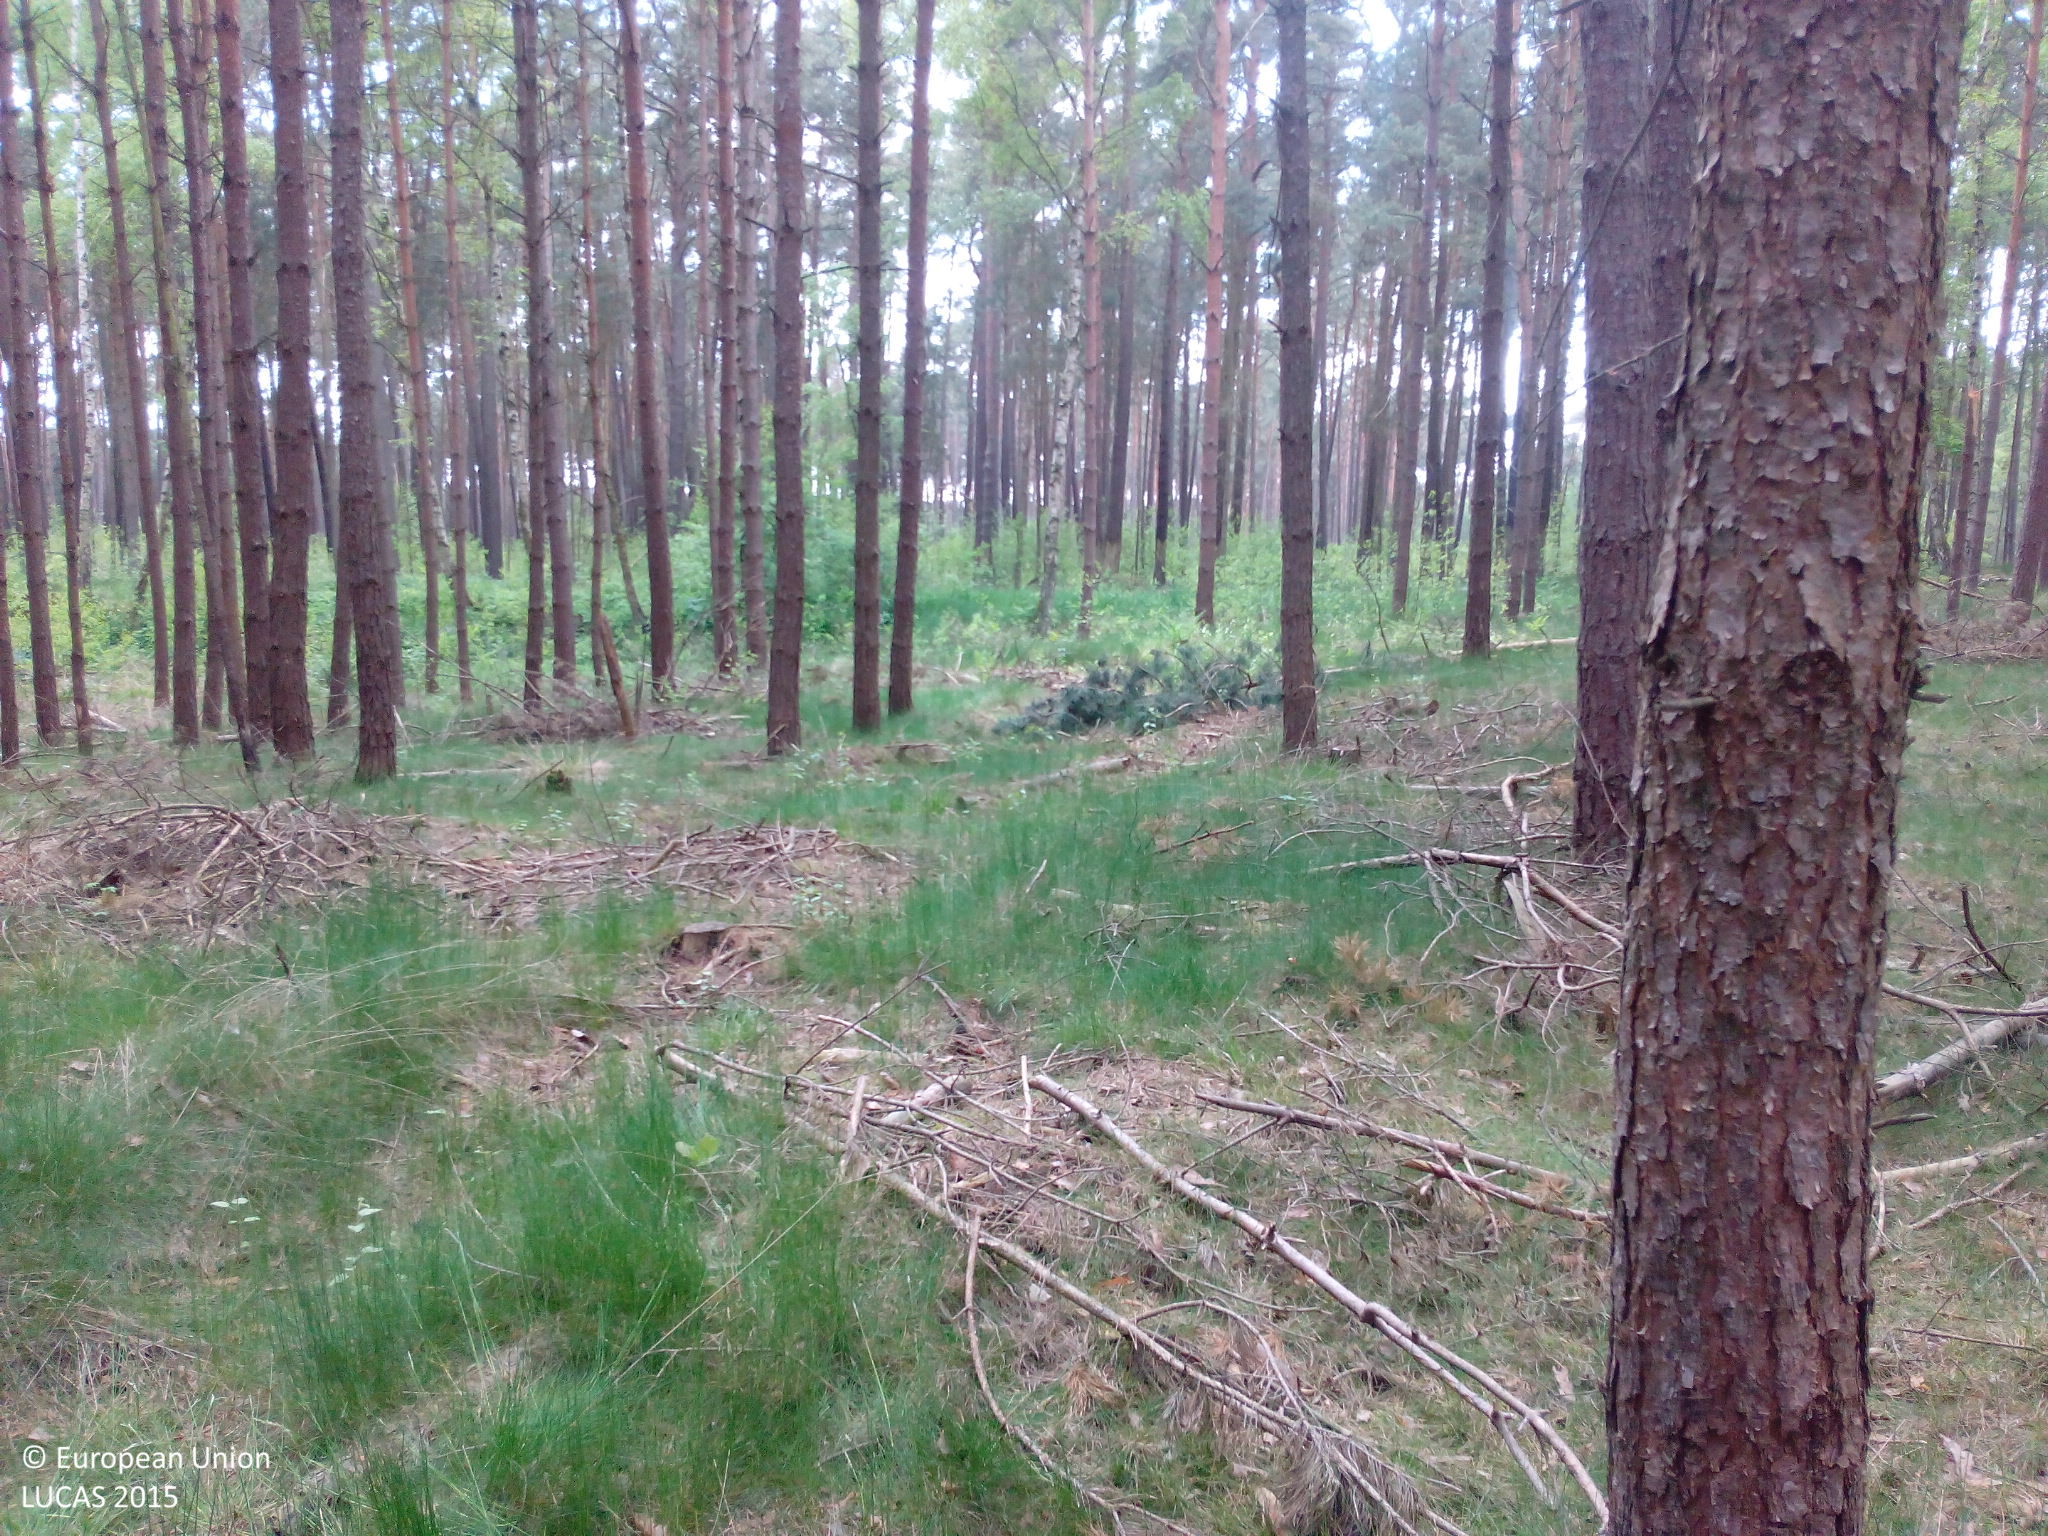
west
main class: Woodland
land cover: Pine dominated coniferous woodland
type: hemiboreal forest and nemoral coniferous forest and mixed broadleaved-coniferous forest
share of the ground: 50 - 75 %
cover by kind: coniferous forest trees 70 %, herbaceous plants 30 %
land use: Forestry
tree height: > 5 m
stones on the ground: < 10 %
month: May
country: DE
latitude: 52.6956
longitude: 11.1389
